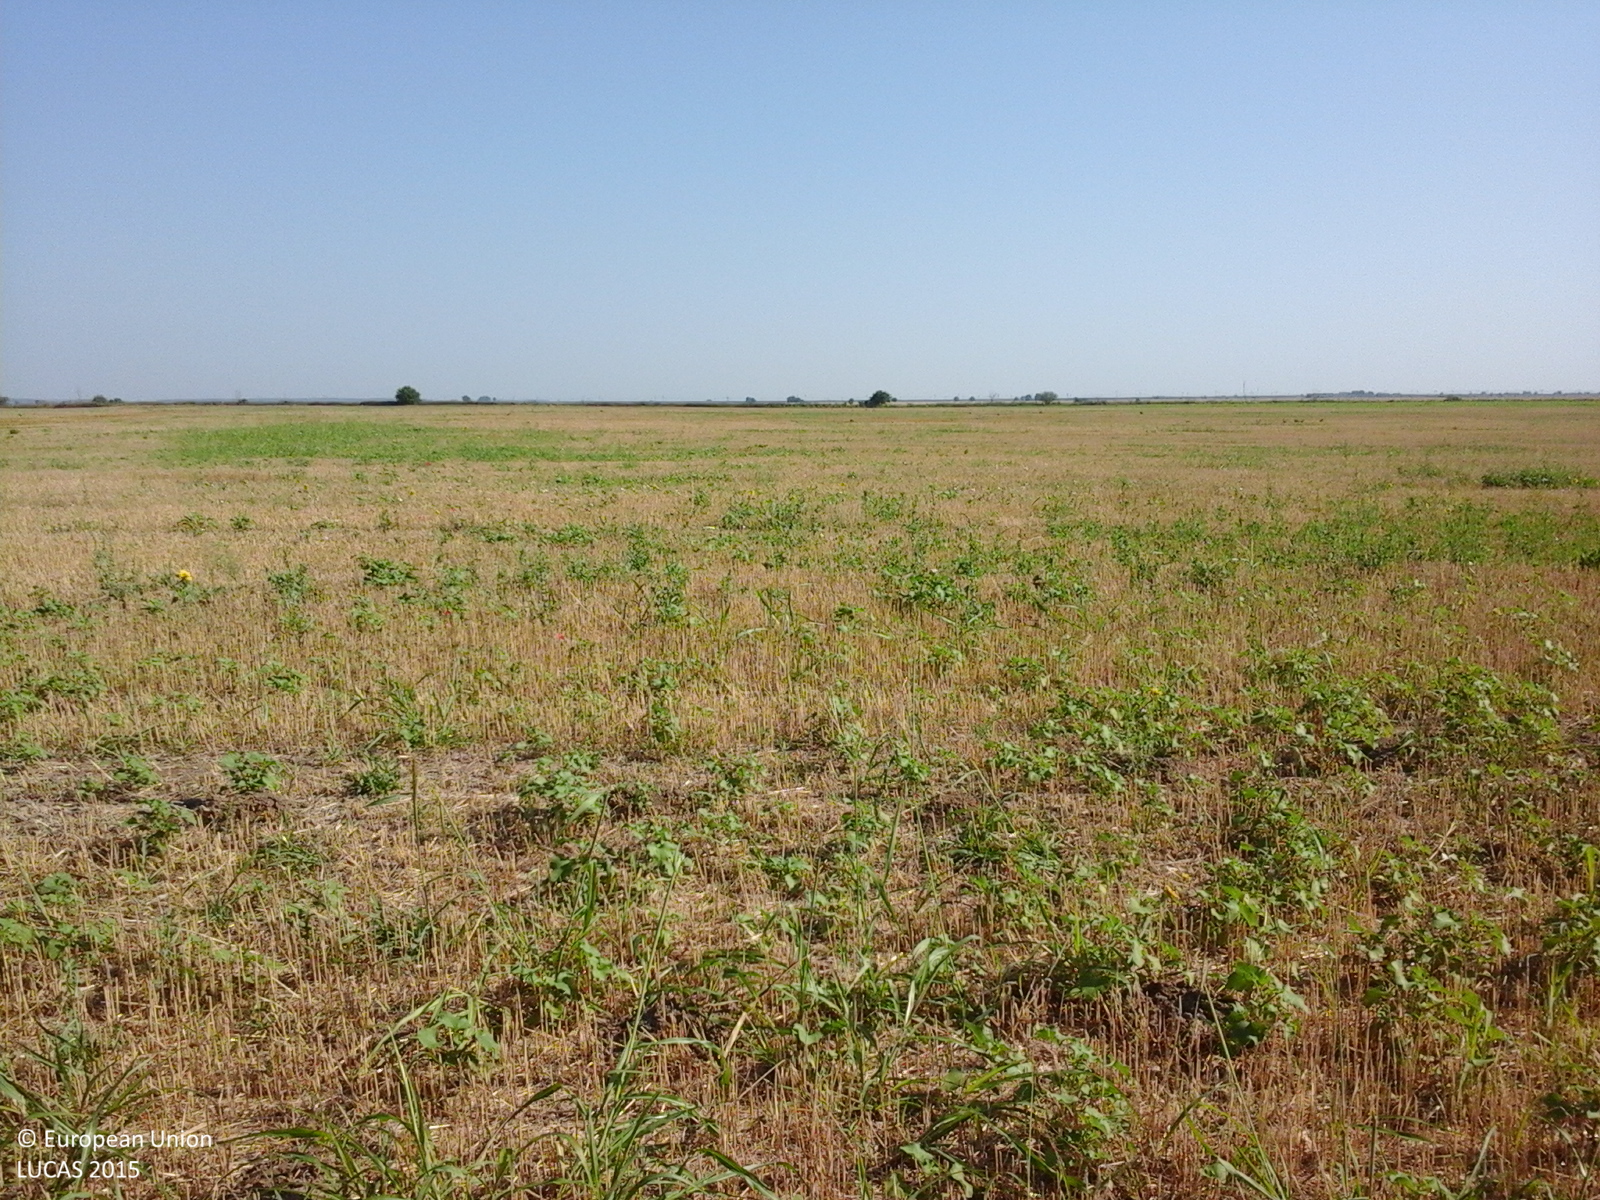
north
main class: Cropland
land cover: Durum wheat
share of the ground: 25 - 50 %
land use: Agriculture (excluding fallow land and kitchen gardens)
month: July
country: RO
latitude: 44.3194
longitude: 27.9460
